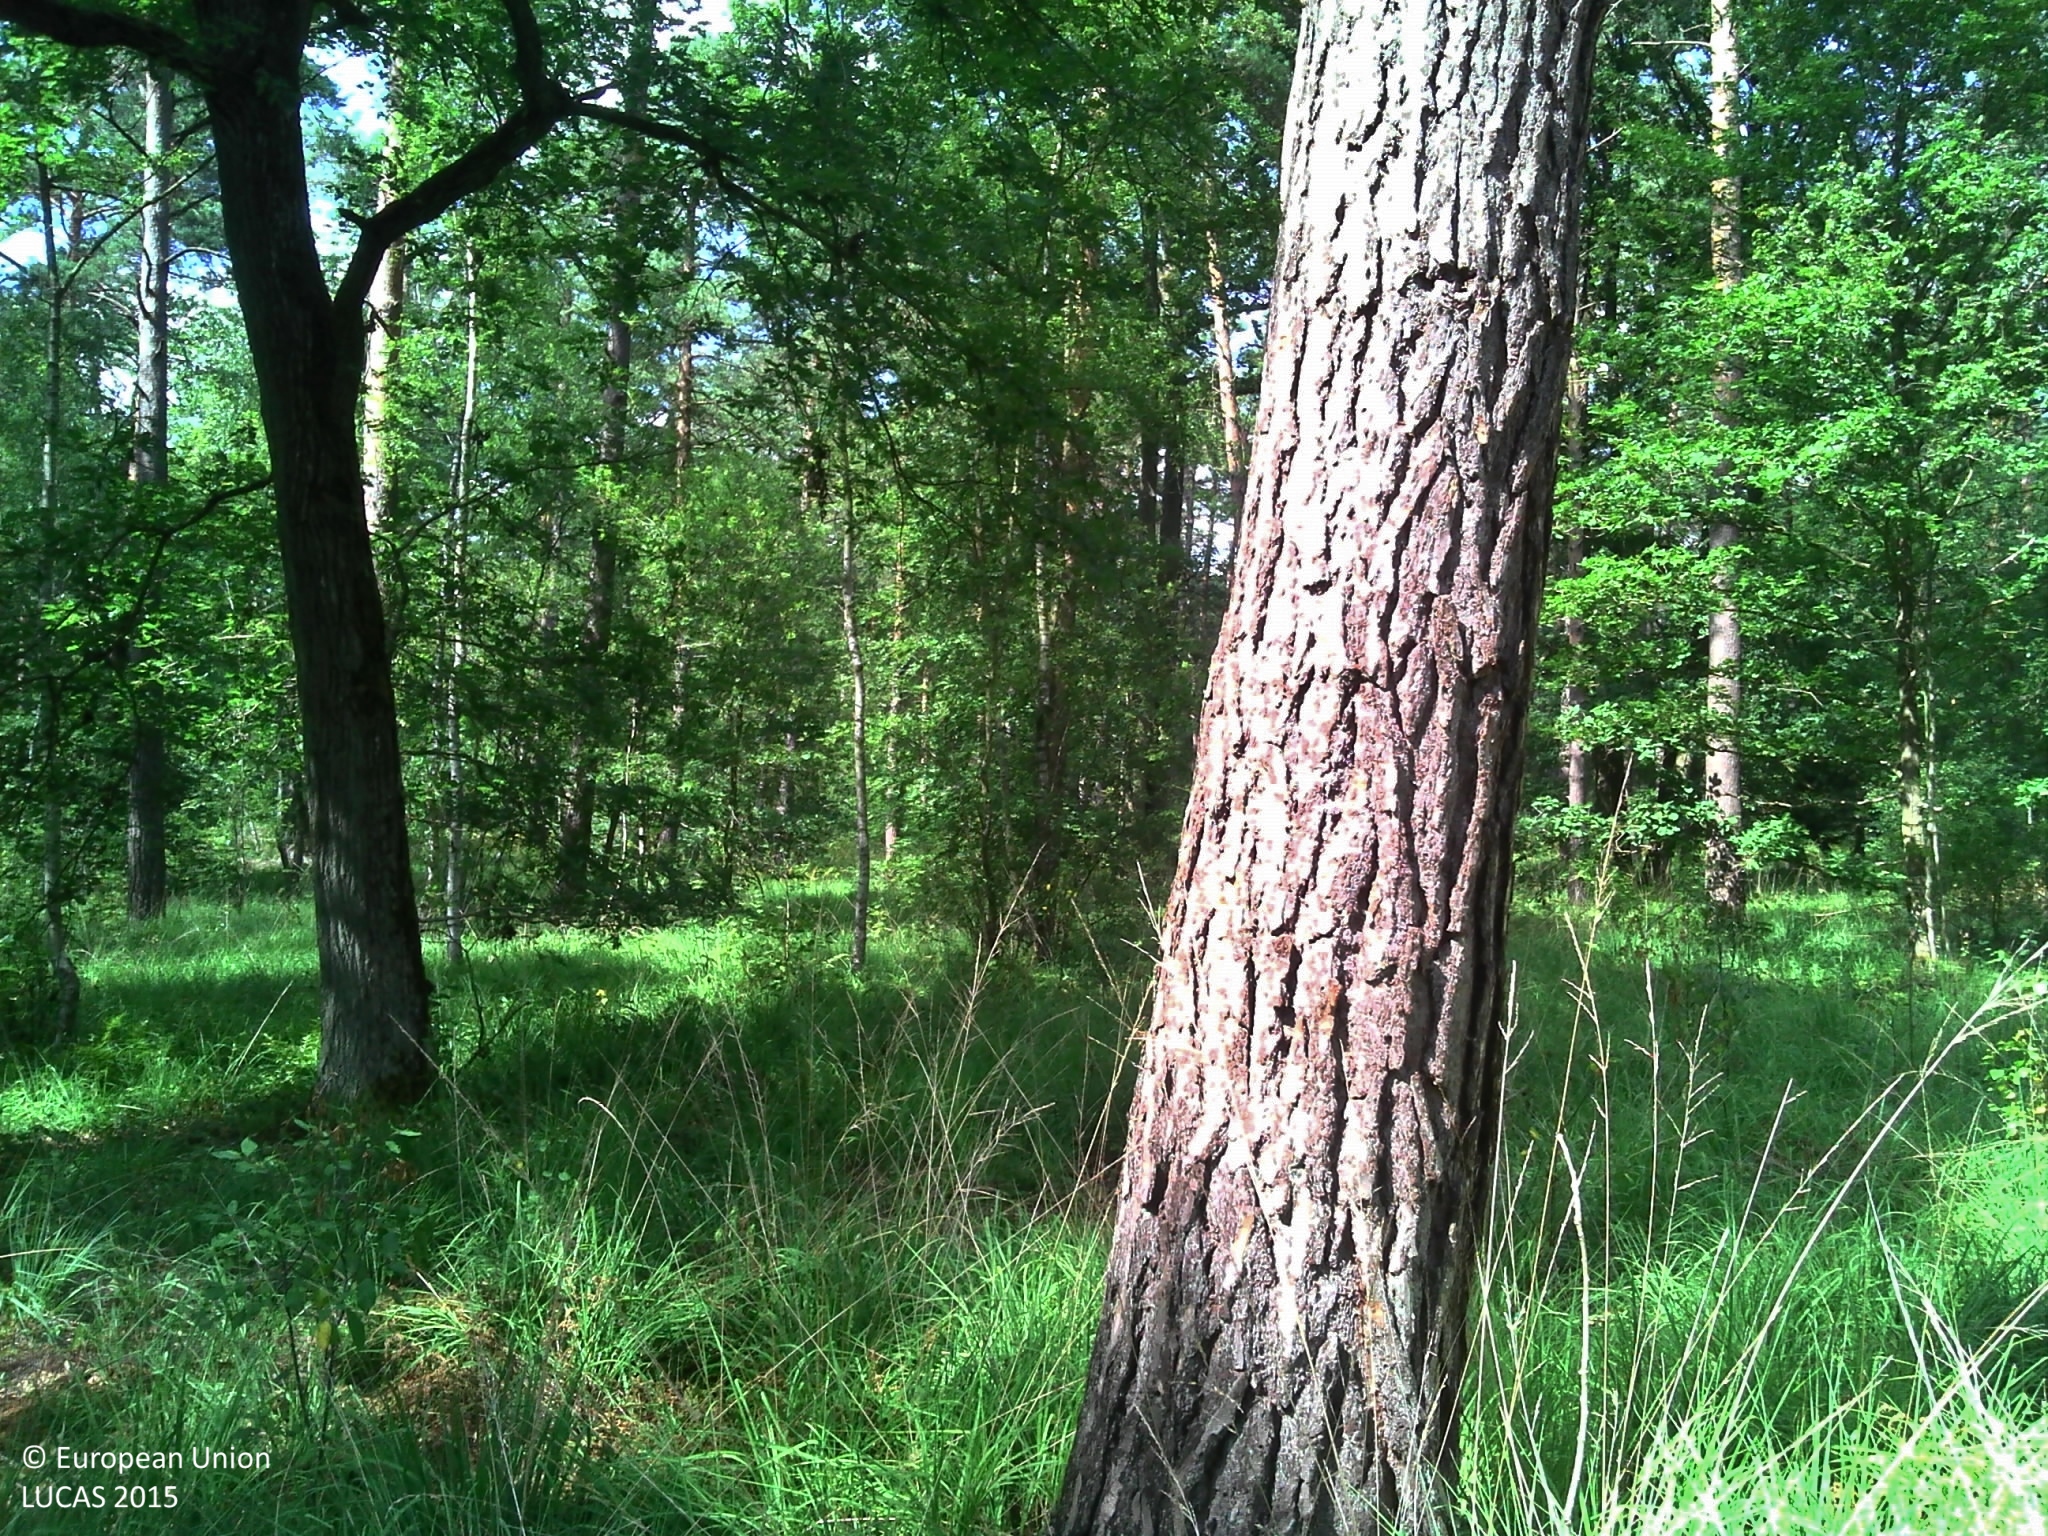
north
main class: Woodland
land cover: Pine dominated mixed woodland
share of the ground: > 75 %
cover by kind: coniferous forest trees 40 %, broadleaved forest trees 30 %, herbaceous plants 20 %, shrubs 10 %
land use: Forestry
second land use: Amenities, museums, leisure
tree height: > 5 m
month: July
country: FR
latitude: 49.1346
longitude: 2.6566
